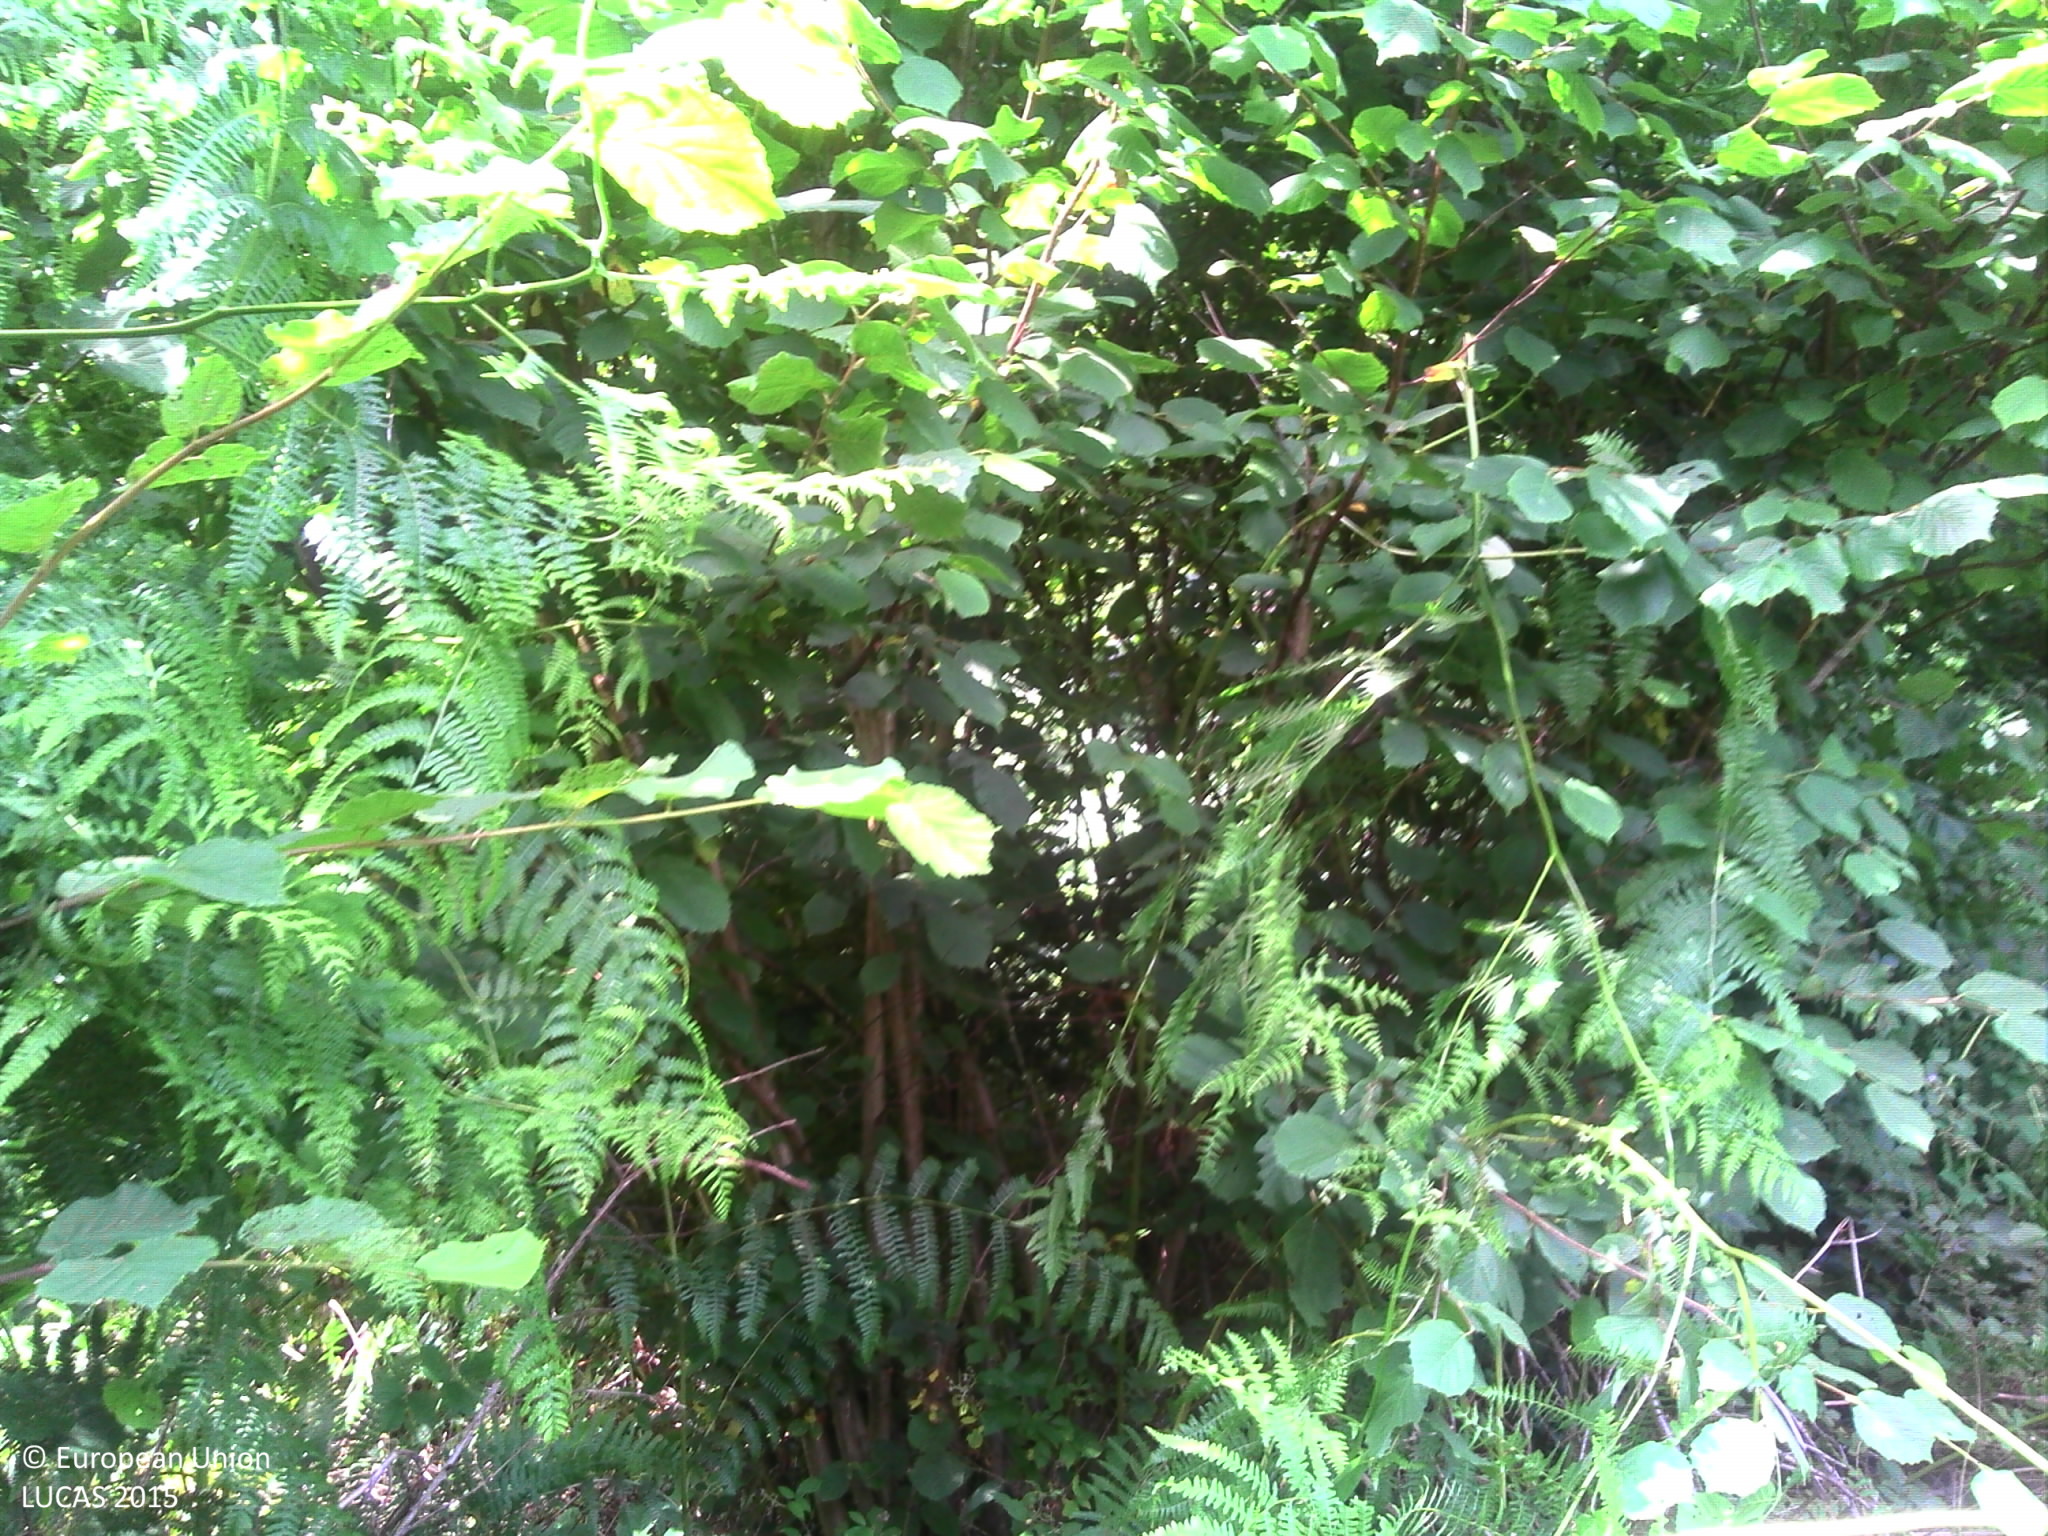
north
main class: Woodland
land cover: Spruce dominated mixed woodland
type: hemiboreal forest and nemoral coniferous forest and mixed broadleaved-coniferous forest
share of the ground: > 75 %
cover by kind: herbaceous plants 45 %, coniferous forest trees 20 %, unconsolidated bare surface 20 %, broadleaved forest trees 15 %
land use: Forestry
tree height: > 5 m
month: July
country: FR
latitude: 48.6388
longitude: -3.4181
